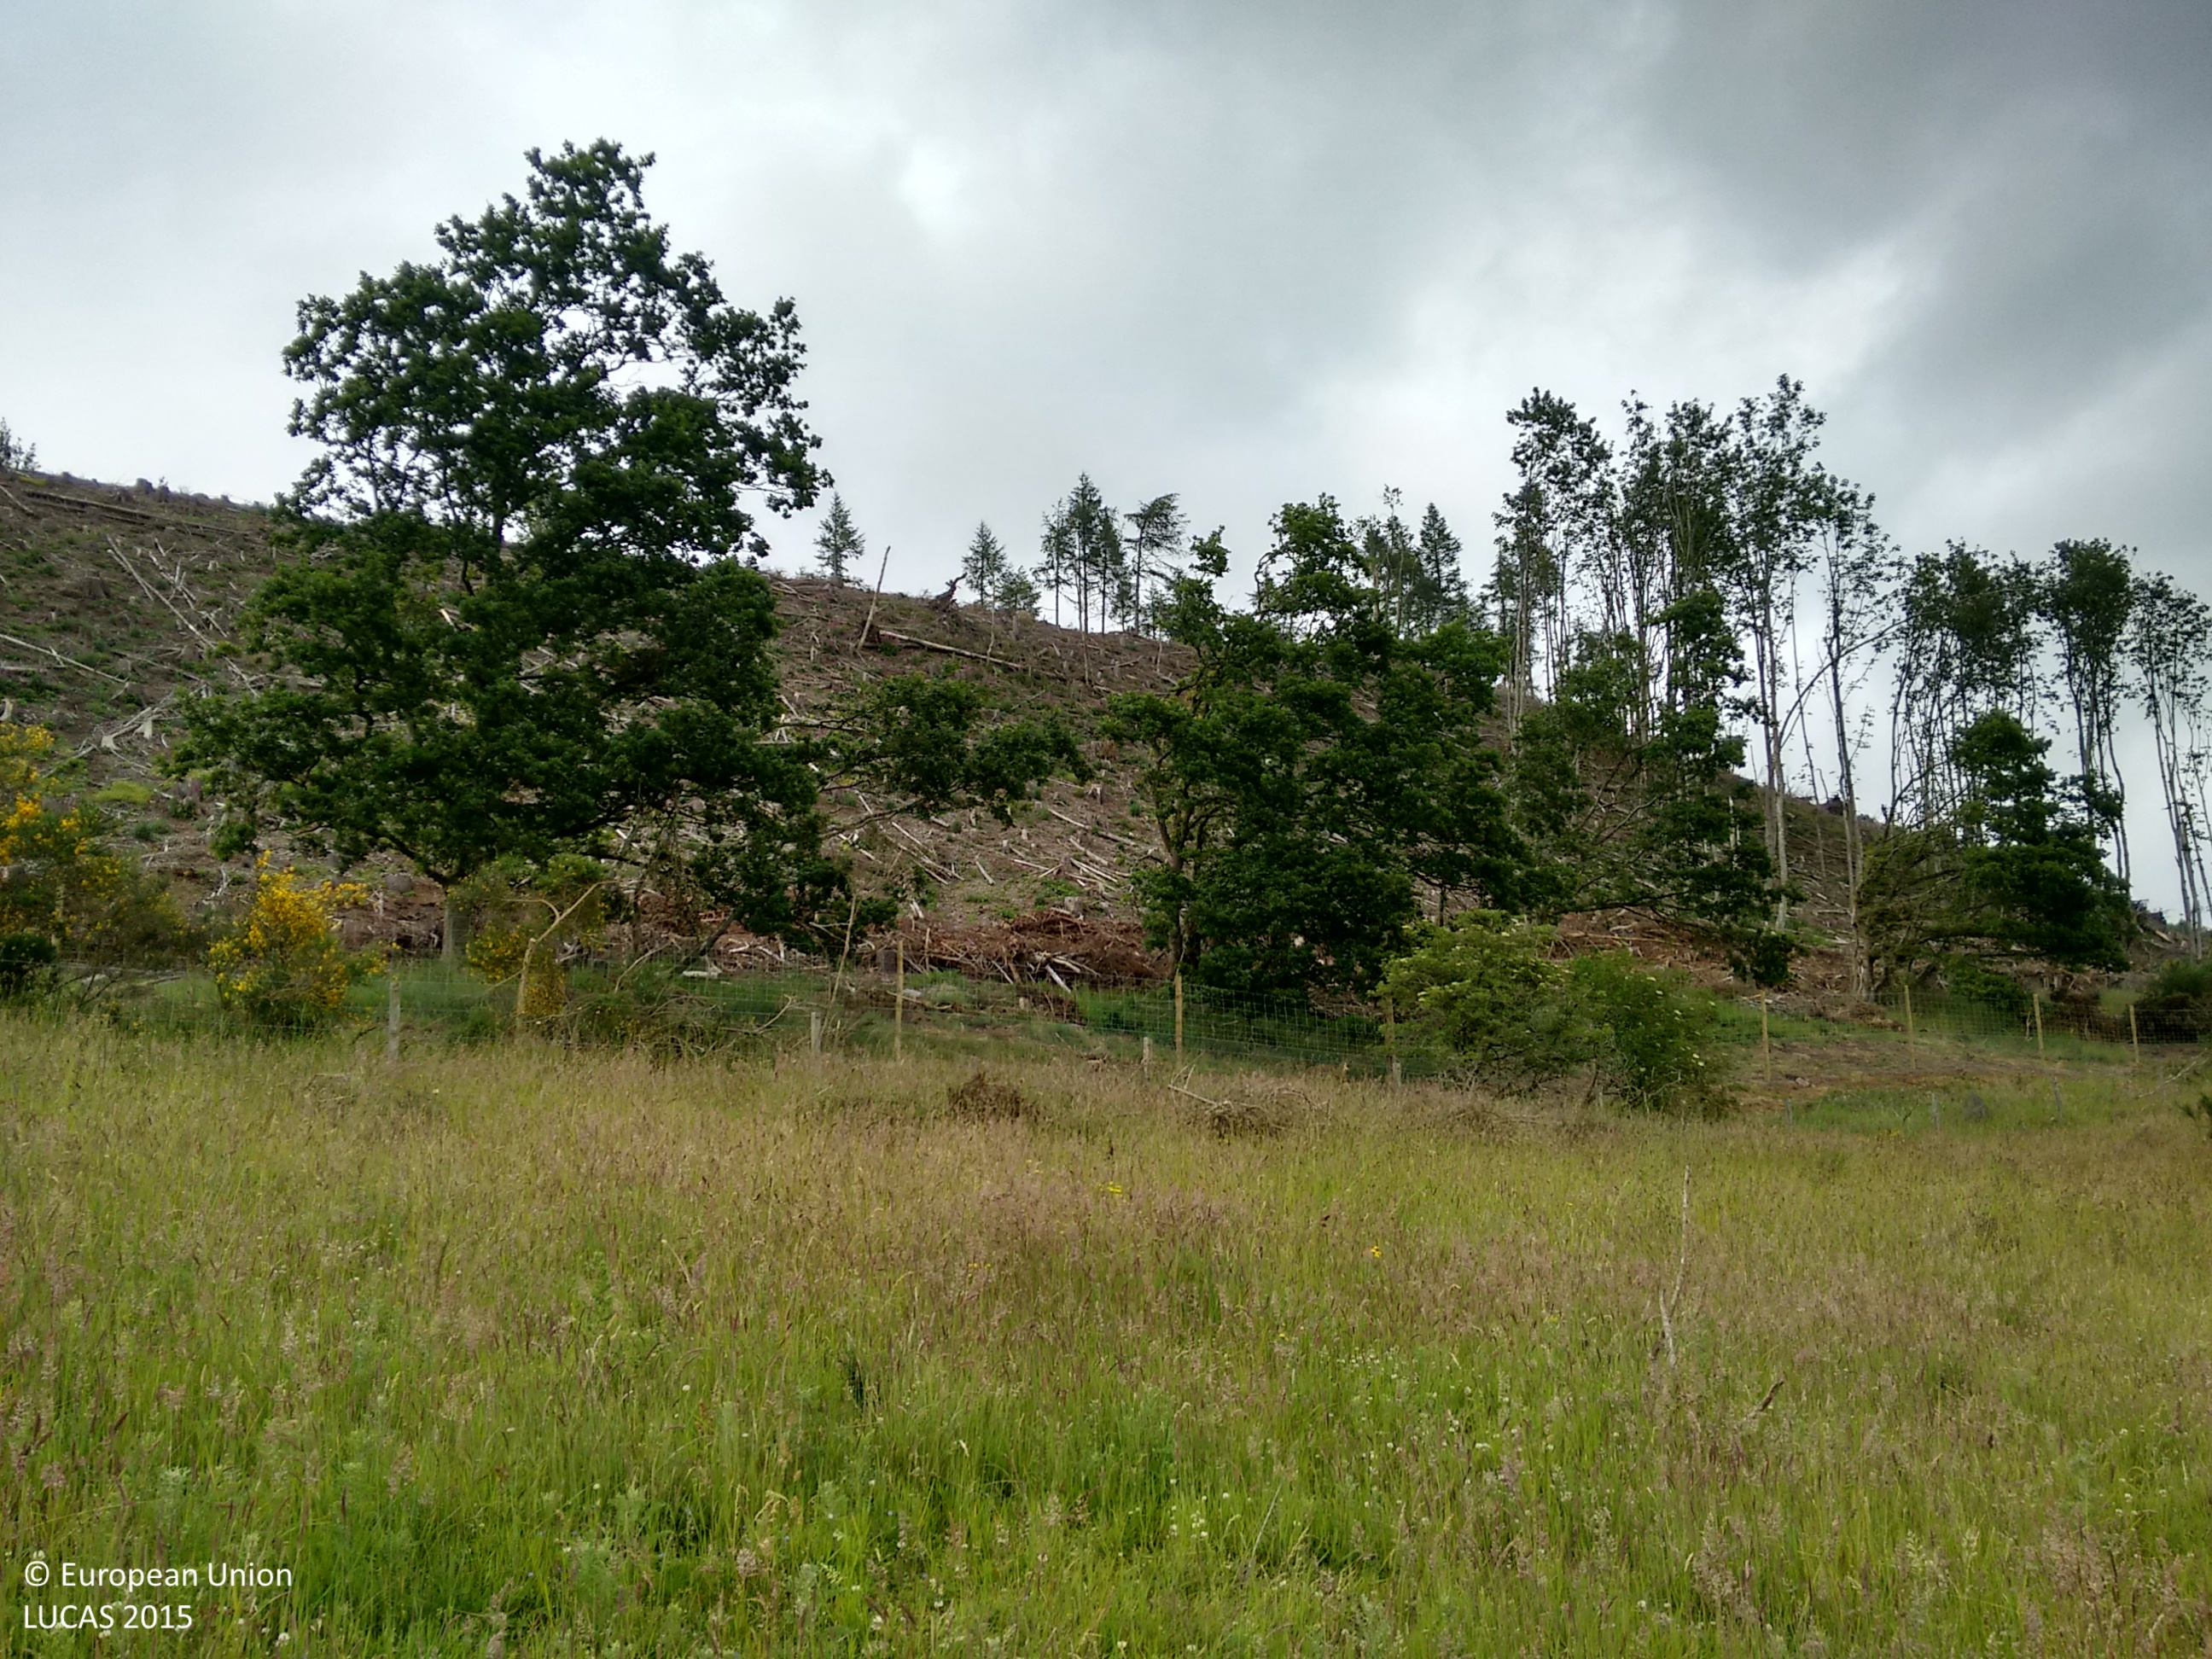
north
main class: Grassland
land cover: Spontaneously vegetated surfaces
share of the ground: > 75 %
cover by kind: herbaceous plants 100 %
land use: Semi-natural and natural areas not in use
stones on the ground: 10 - 25 %
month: June
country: GB
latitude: 56.5690
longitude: -3.4684
